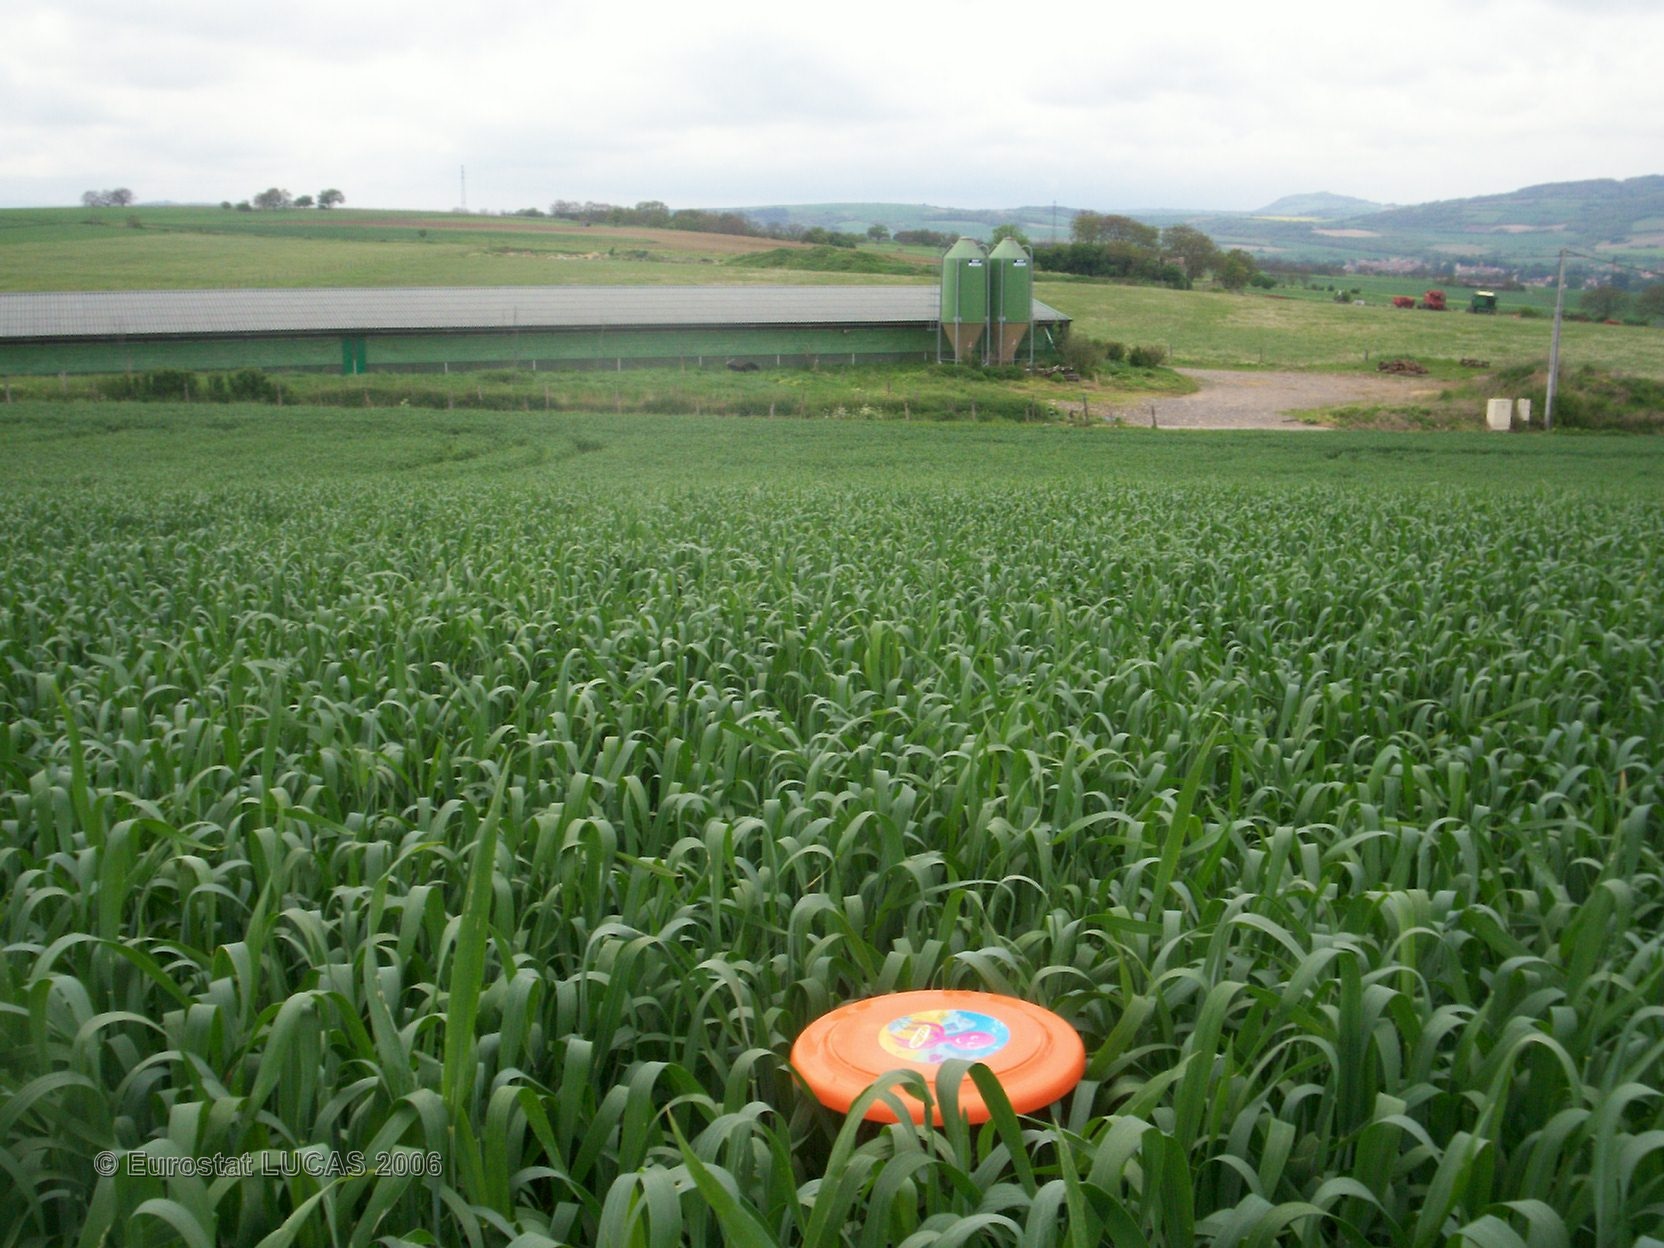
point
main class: Cropland
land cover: Common wheat
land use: Agriculture (excluding fallow land and kitchen gardens)
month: May
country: FR
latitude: 45.6279
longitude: 3.1895
